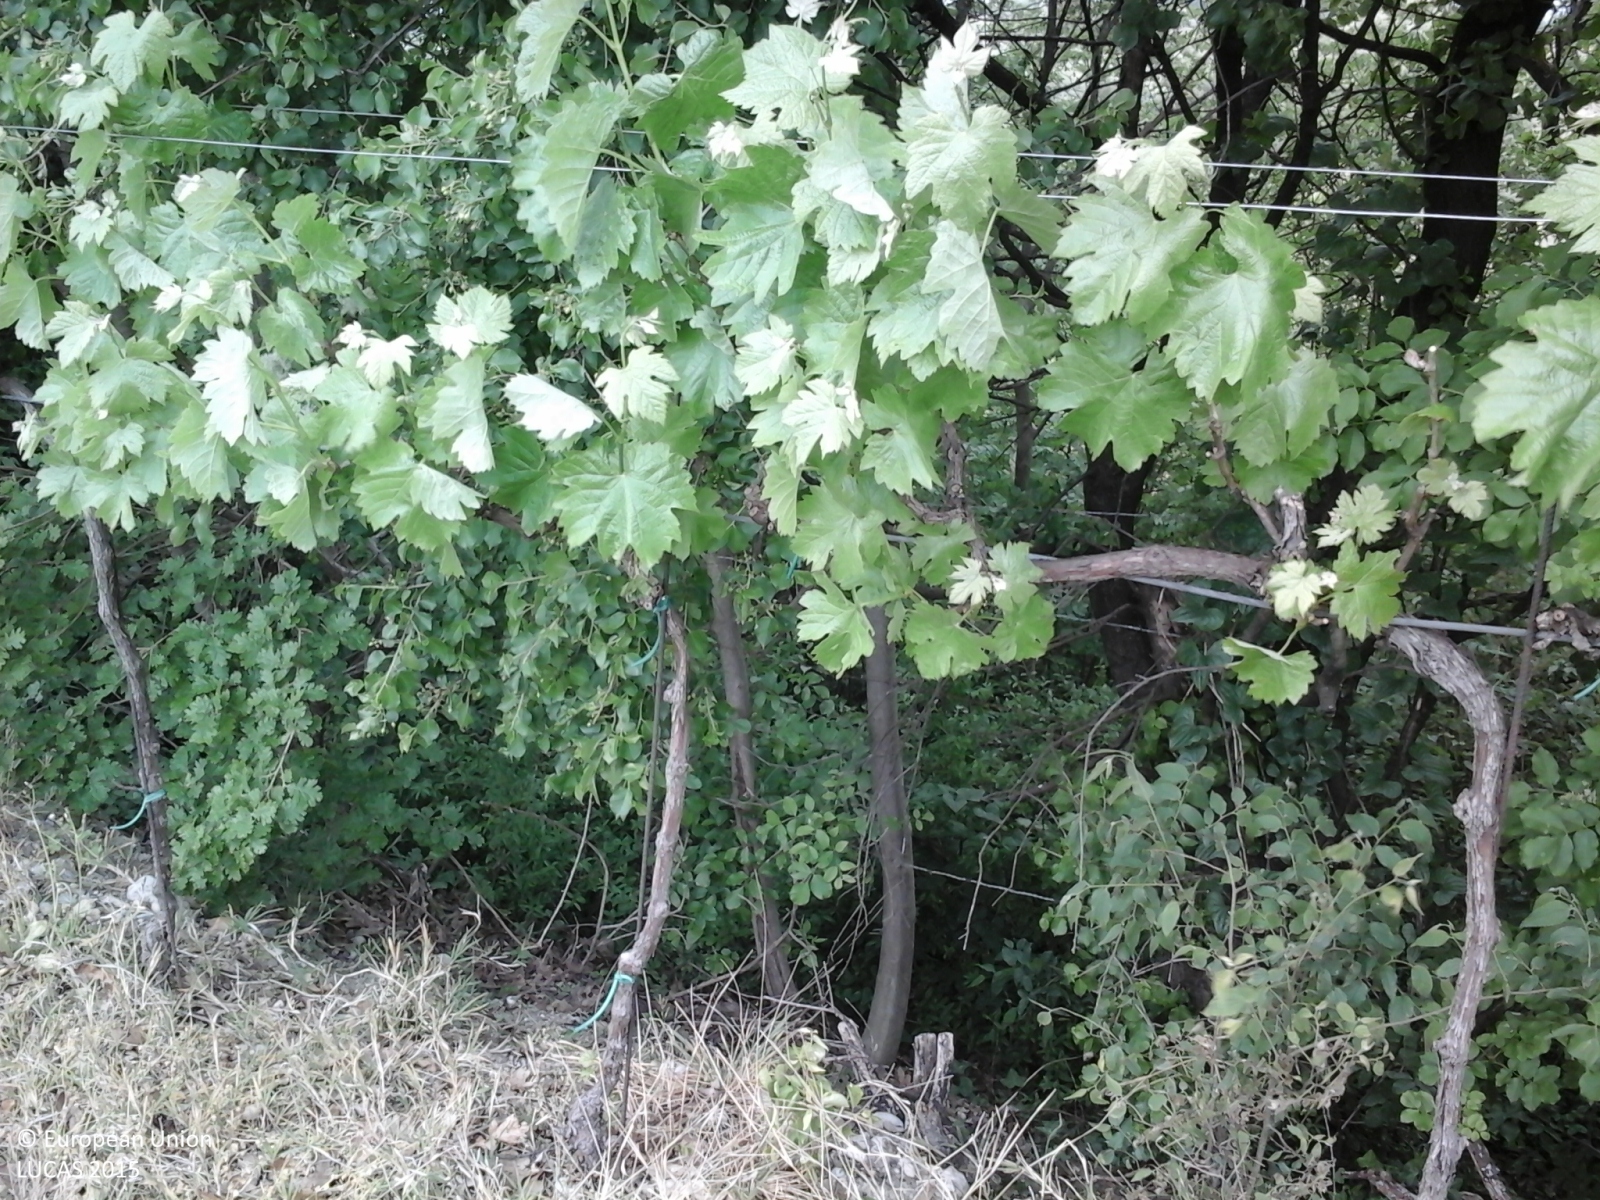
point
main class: Woodland
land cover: Broadleaved woodland
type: mesophytic deciduous forest
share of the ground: > 75 %
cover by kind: broadleaved forest trees 100 %
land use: Semi-natural and natural areas not in use
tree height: > 5 m
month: April
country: IT
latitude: 45.3584
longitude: 10.6244
